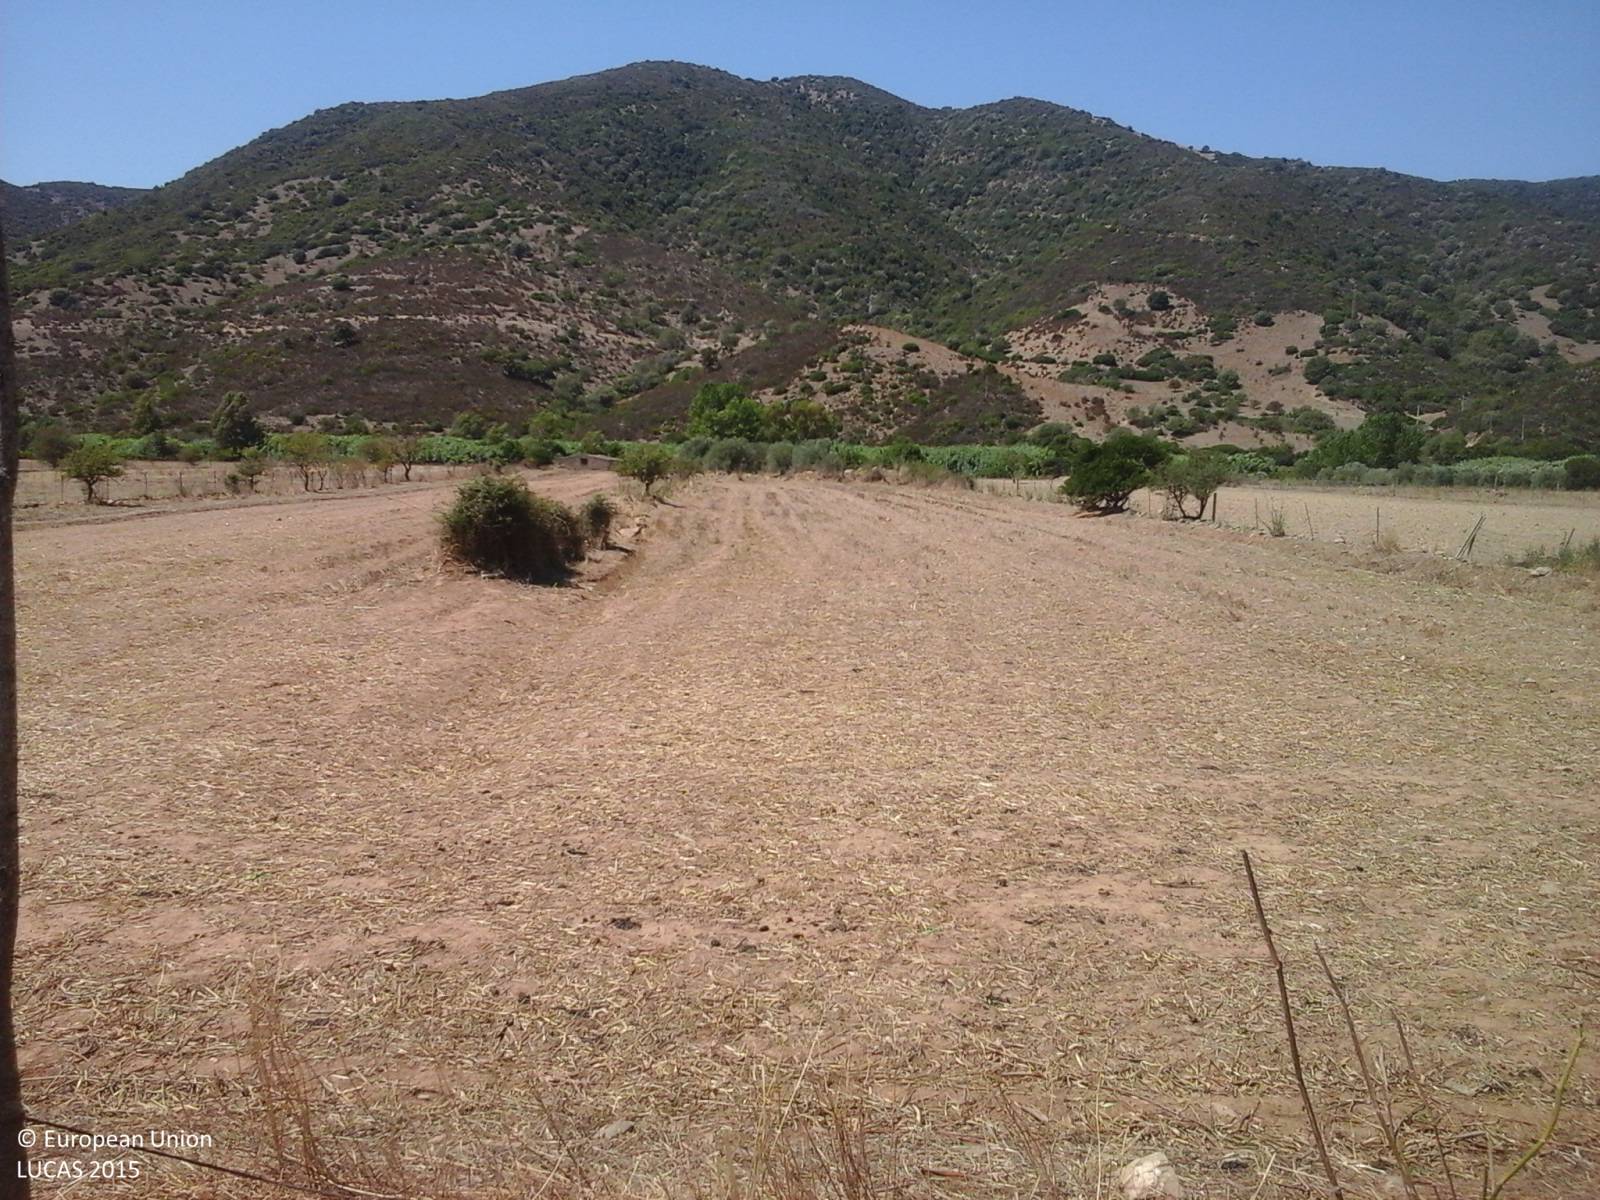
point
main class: Cropland
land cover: Temporary grasslands
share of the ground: 25 - 50 %
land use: Agriculture (excluding fallow land and kitchen gardens)
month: August
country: IT
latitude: 39.6146
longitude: 9.5947
